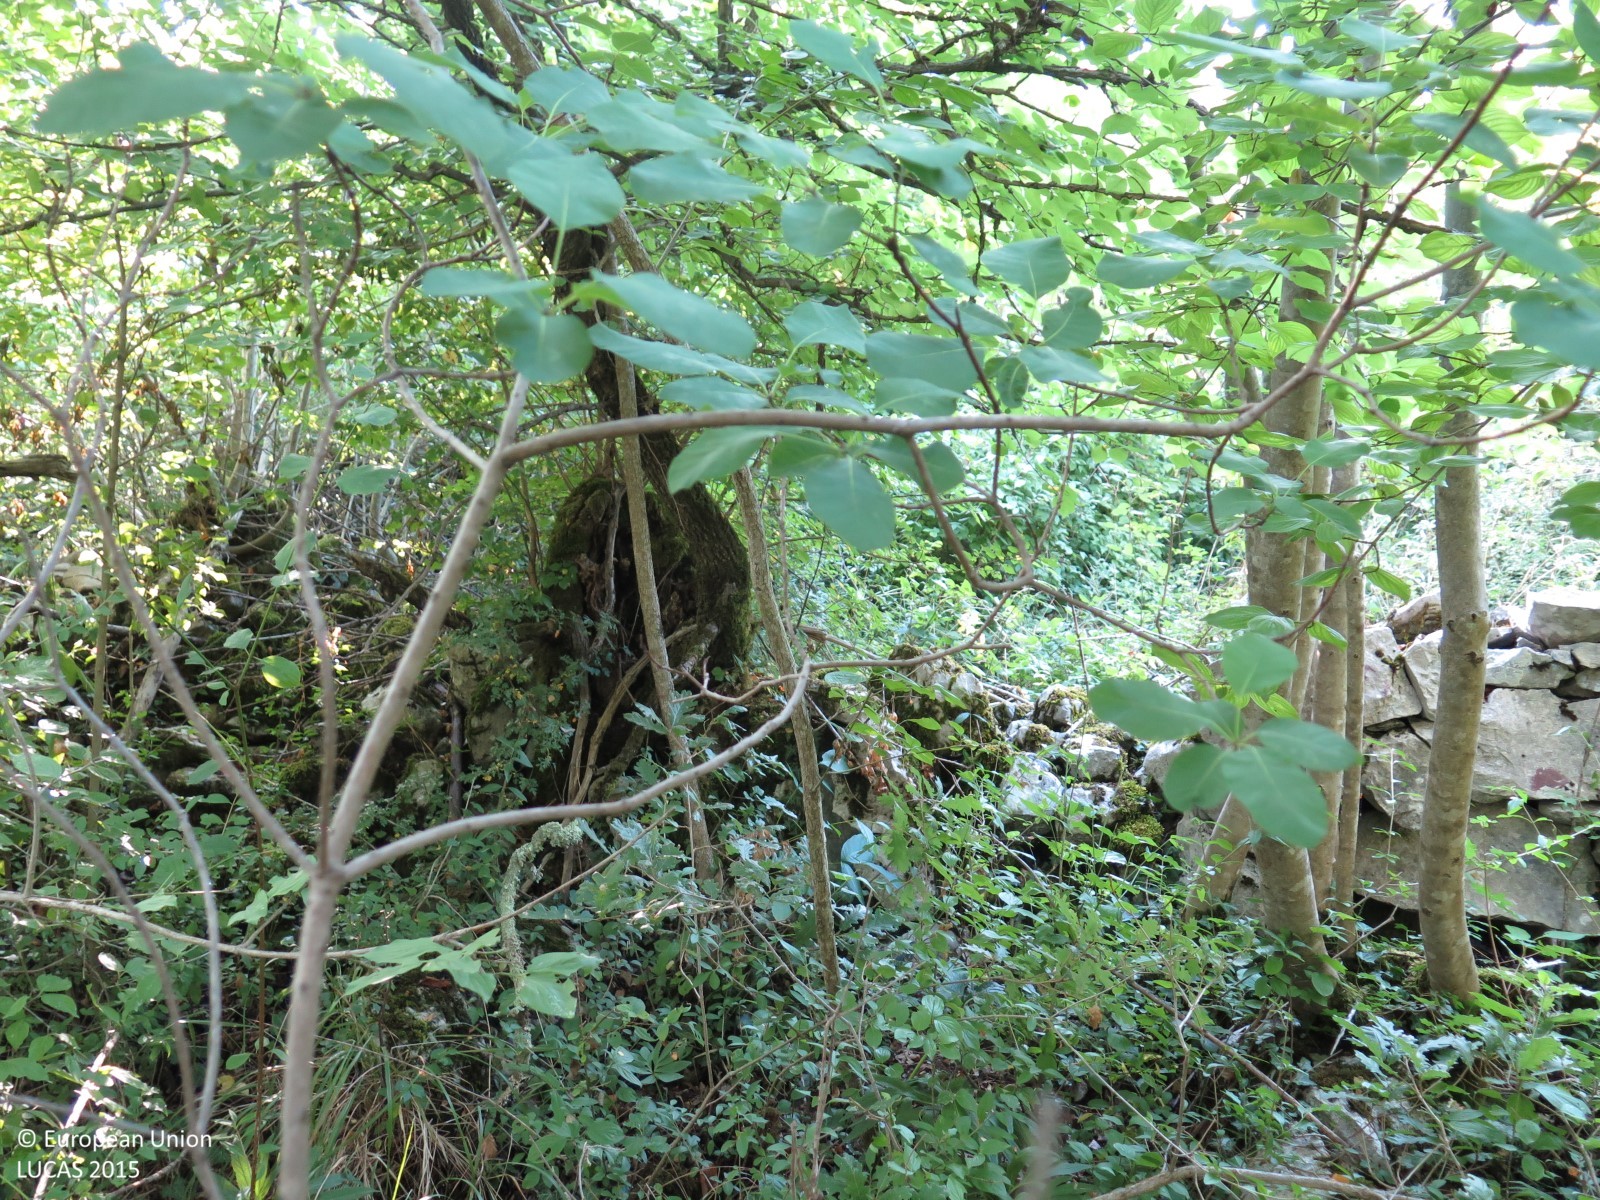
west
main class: Woodland
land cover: Broadleaved woodland
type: acidophilous oak and oak-birch forest
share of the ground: > 75 %
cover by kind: broadleaved forest trees 90 %, shrubs 5 %, herbaceous plants 5 %
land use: Semi-natural and natural areas not in use
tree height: > 5 m
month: July
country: HR
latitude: 45.3719
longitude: 14.0683
